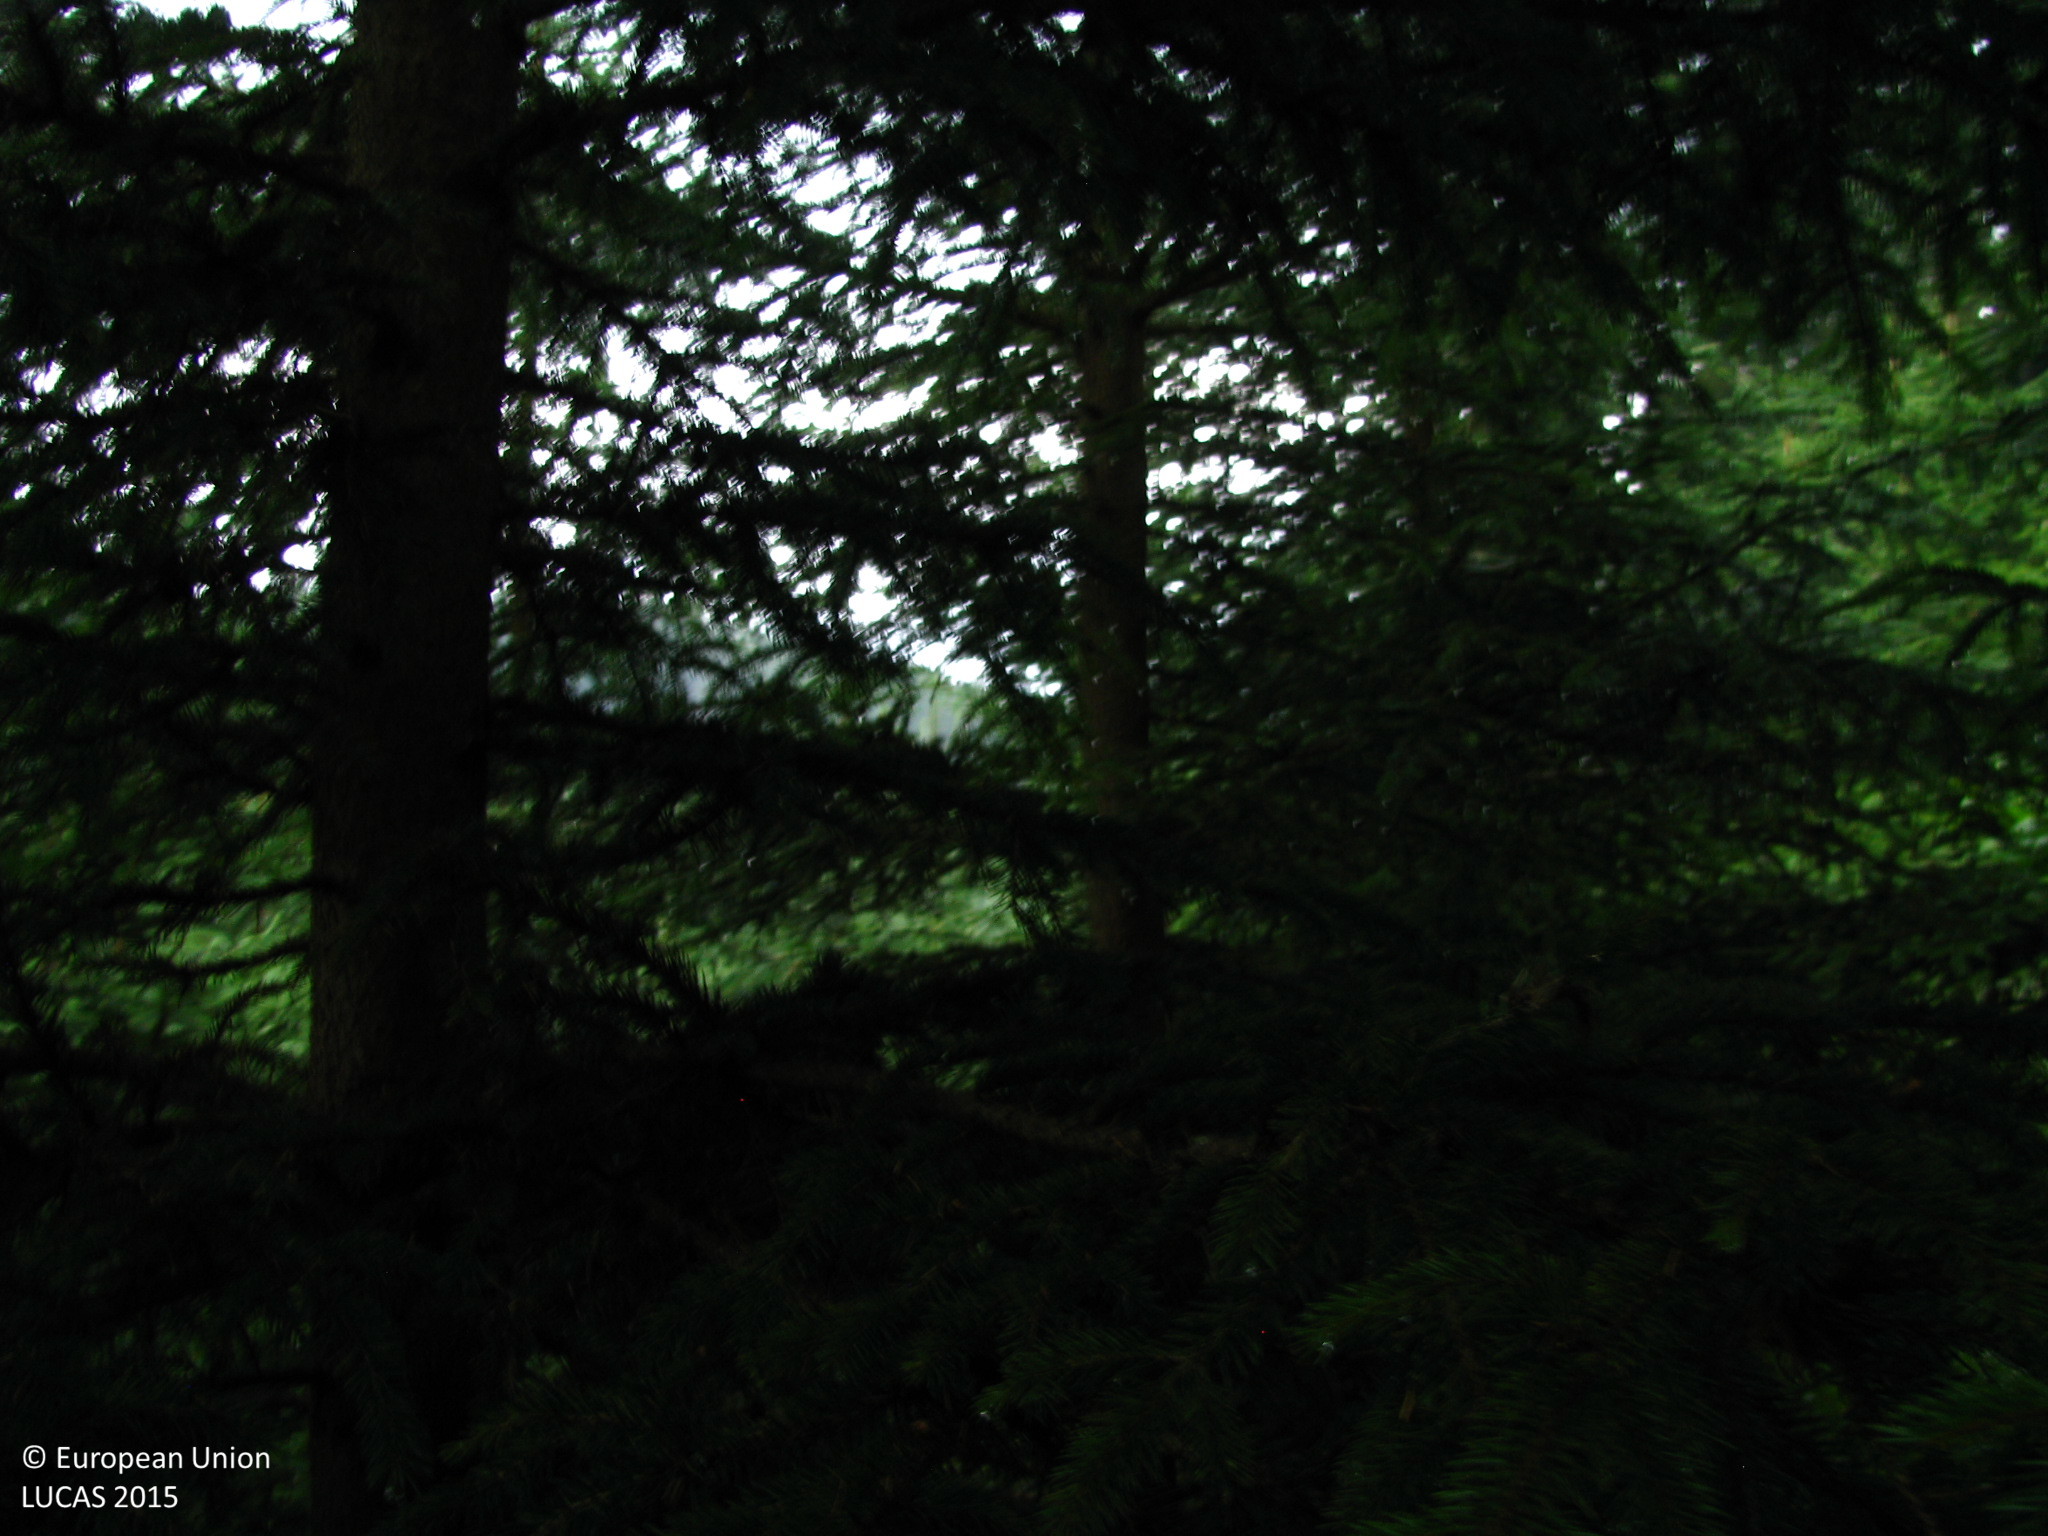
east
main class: Woodland
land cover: Spruce dominated coniferous woodland
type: alpine coniferous forest
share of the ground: 50 - 75 %
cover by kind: coniferous forest trees 75 %, herbaceous plants 25 %
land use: Forestry
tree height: > 5 m
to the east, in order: Spruce dominated coniferous woodland; Shrubland with sparse tree cover; Spruce dominated coniferous woodland; Rivers and streams; Spontaneously vegetated surfaces; Paved roads, cycling and walking lanes; Spontaneously vegetated surfaces; Spruce dominated coniferous woodland
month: July
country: AT
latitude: 47.1472
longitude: 14.7595
